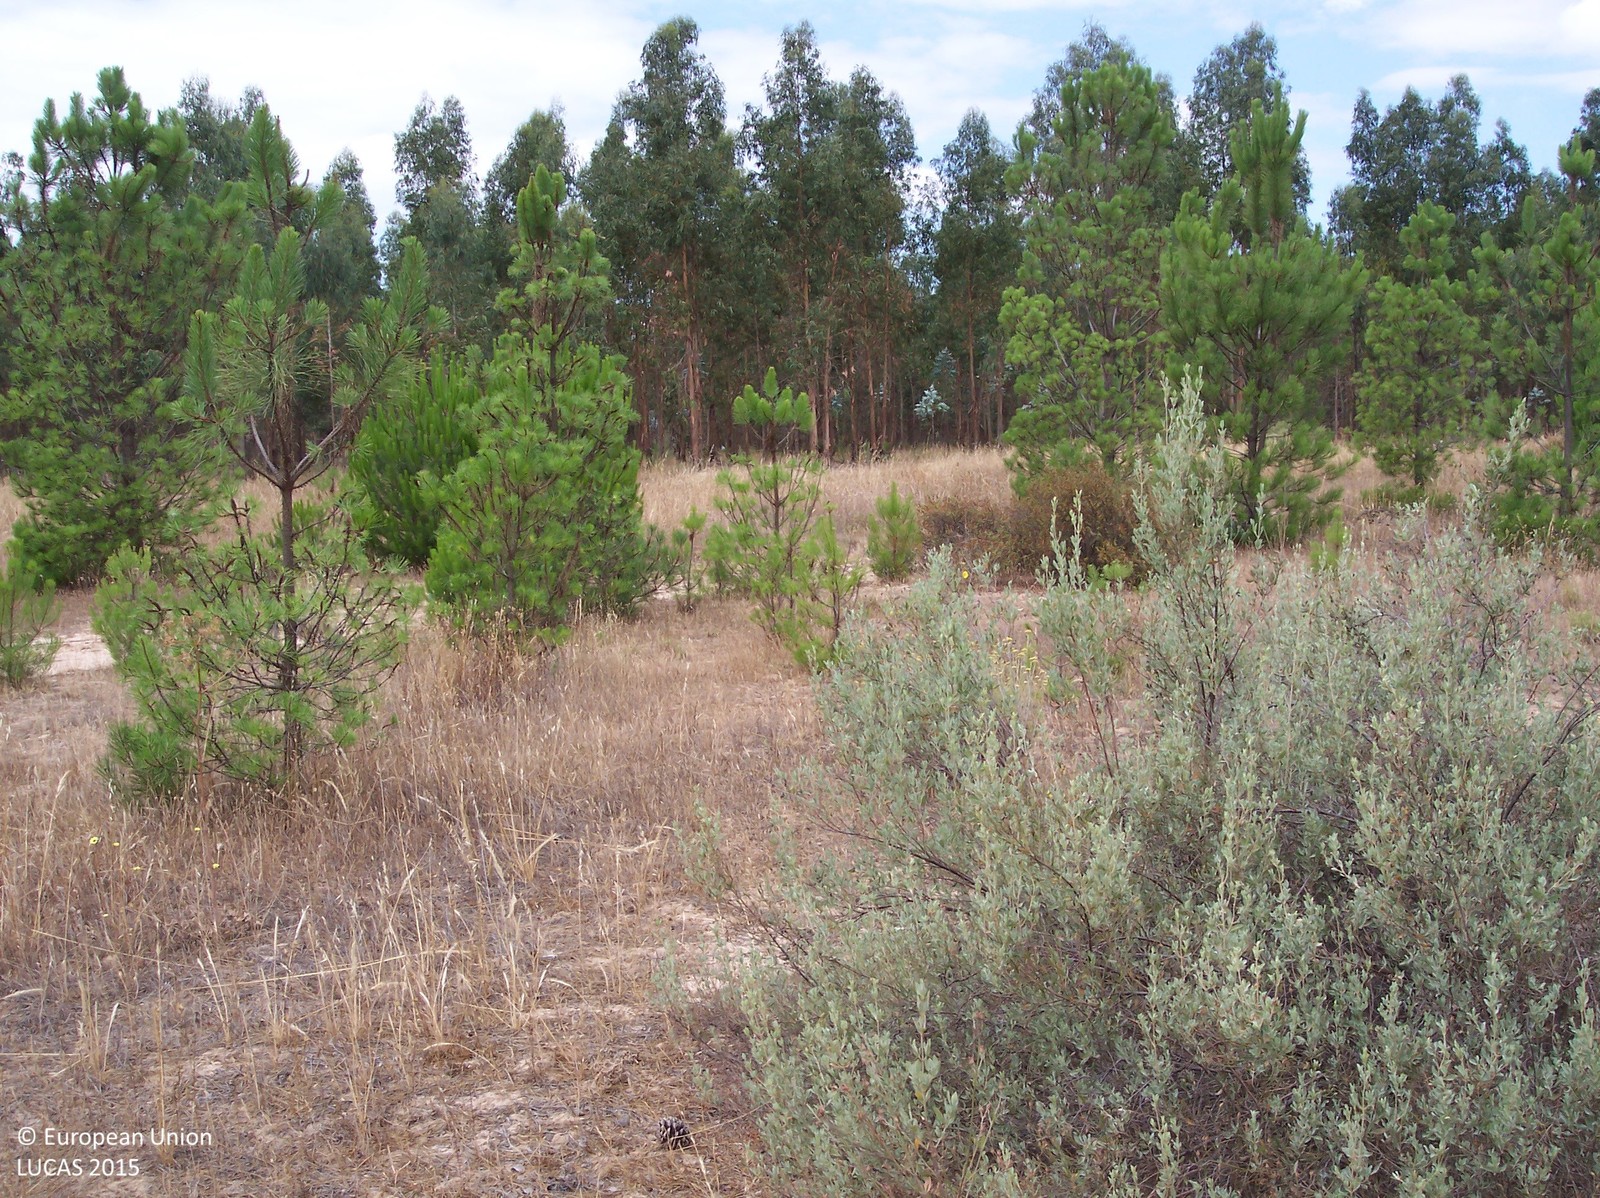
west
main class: Shrubland
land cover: Shrubland with sparse tree cover
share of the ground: > 75 %
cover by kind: shrubs 70 %, herbaceous plants 25 %, coniferous forest trees 5 %
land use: Semi-natural and natural areas not in use
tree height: > 5 m
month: June
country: ES
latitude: 37.3196
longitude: -6.4490
